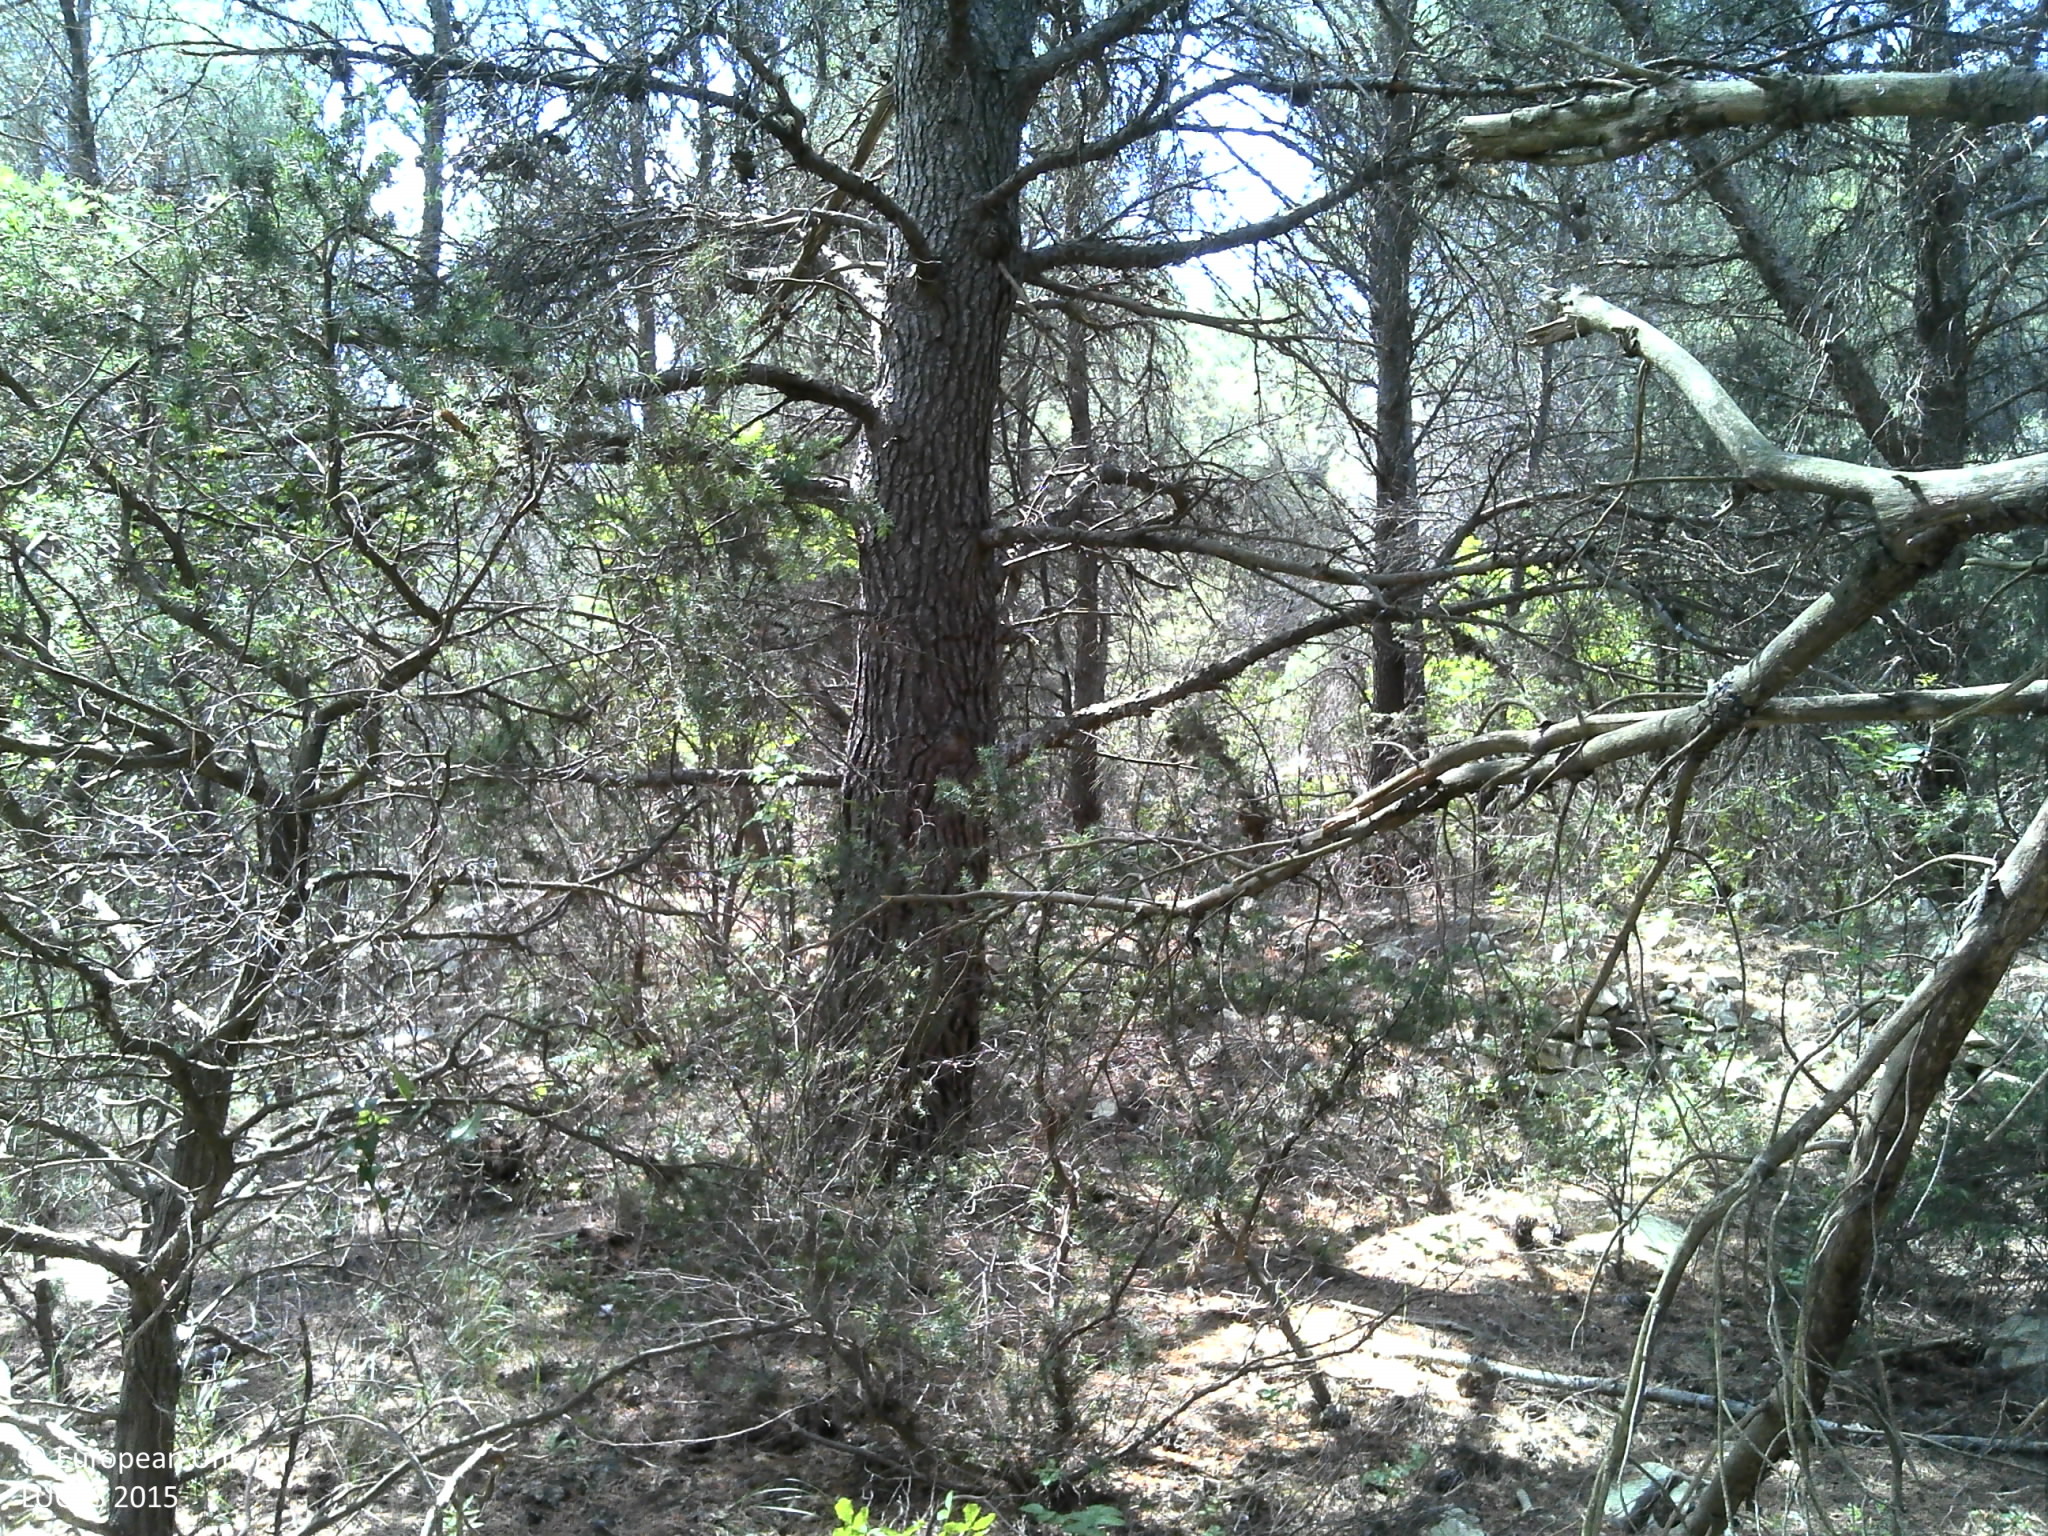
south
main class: Woodland
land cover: Pine dominated coniferous woodland
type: coniferous forest of the mediterranean region
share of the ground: > 75 %
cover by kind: coniferous forest trees 85 %, shrubs 5 %, lichens and mosses 5 %, unconsolidated bare surface 5 %
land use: Semi-natural and natural areas not in use
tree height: > 5 m
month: April
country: HR
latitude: 43.7658
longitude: 15.9165
